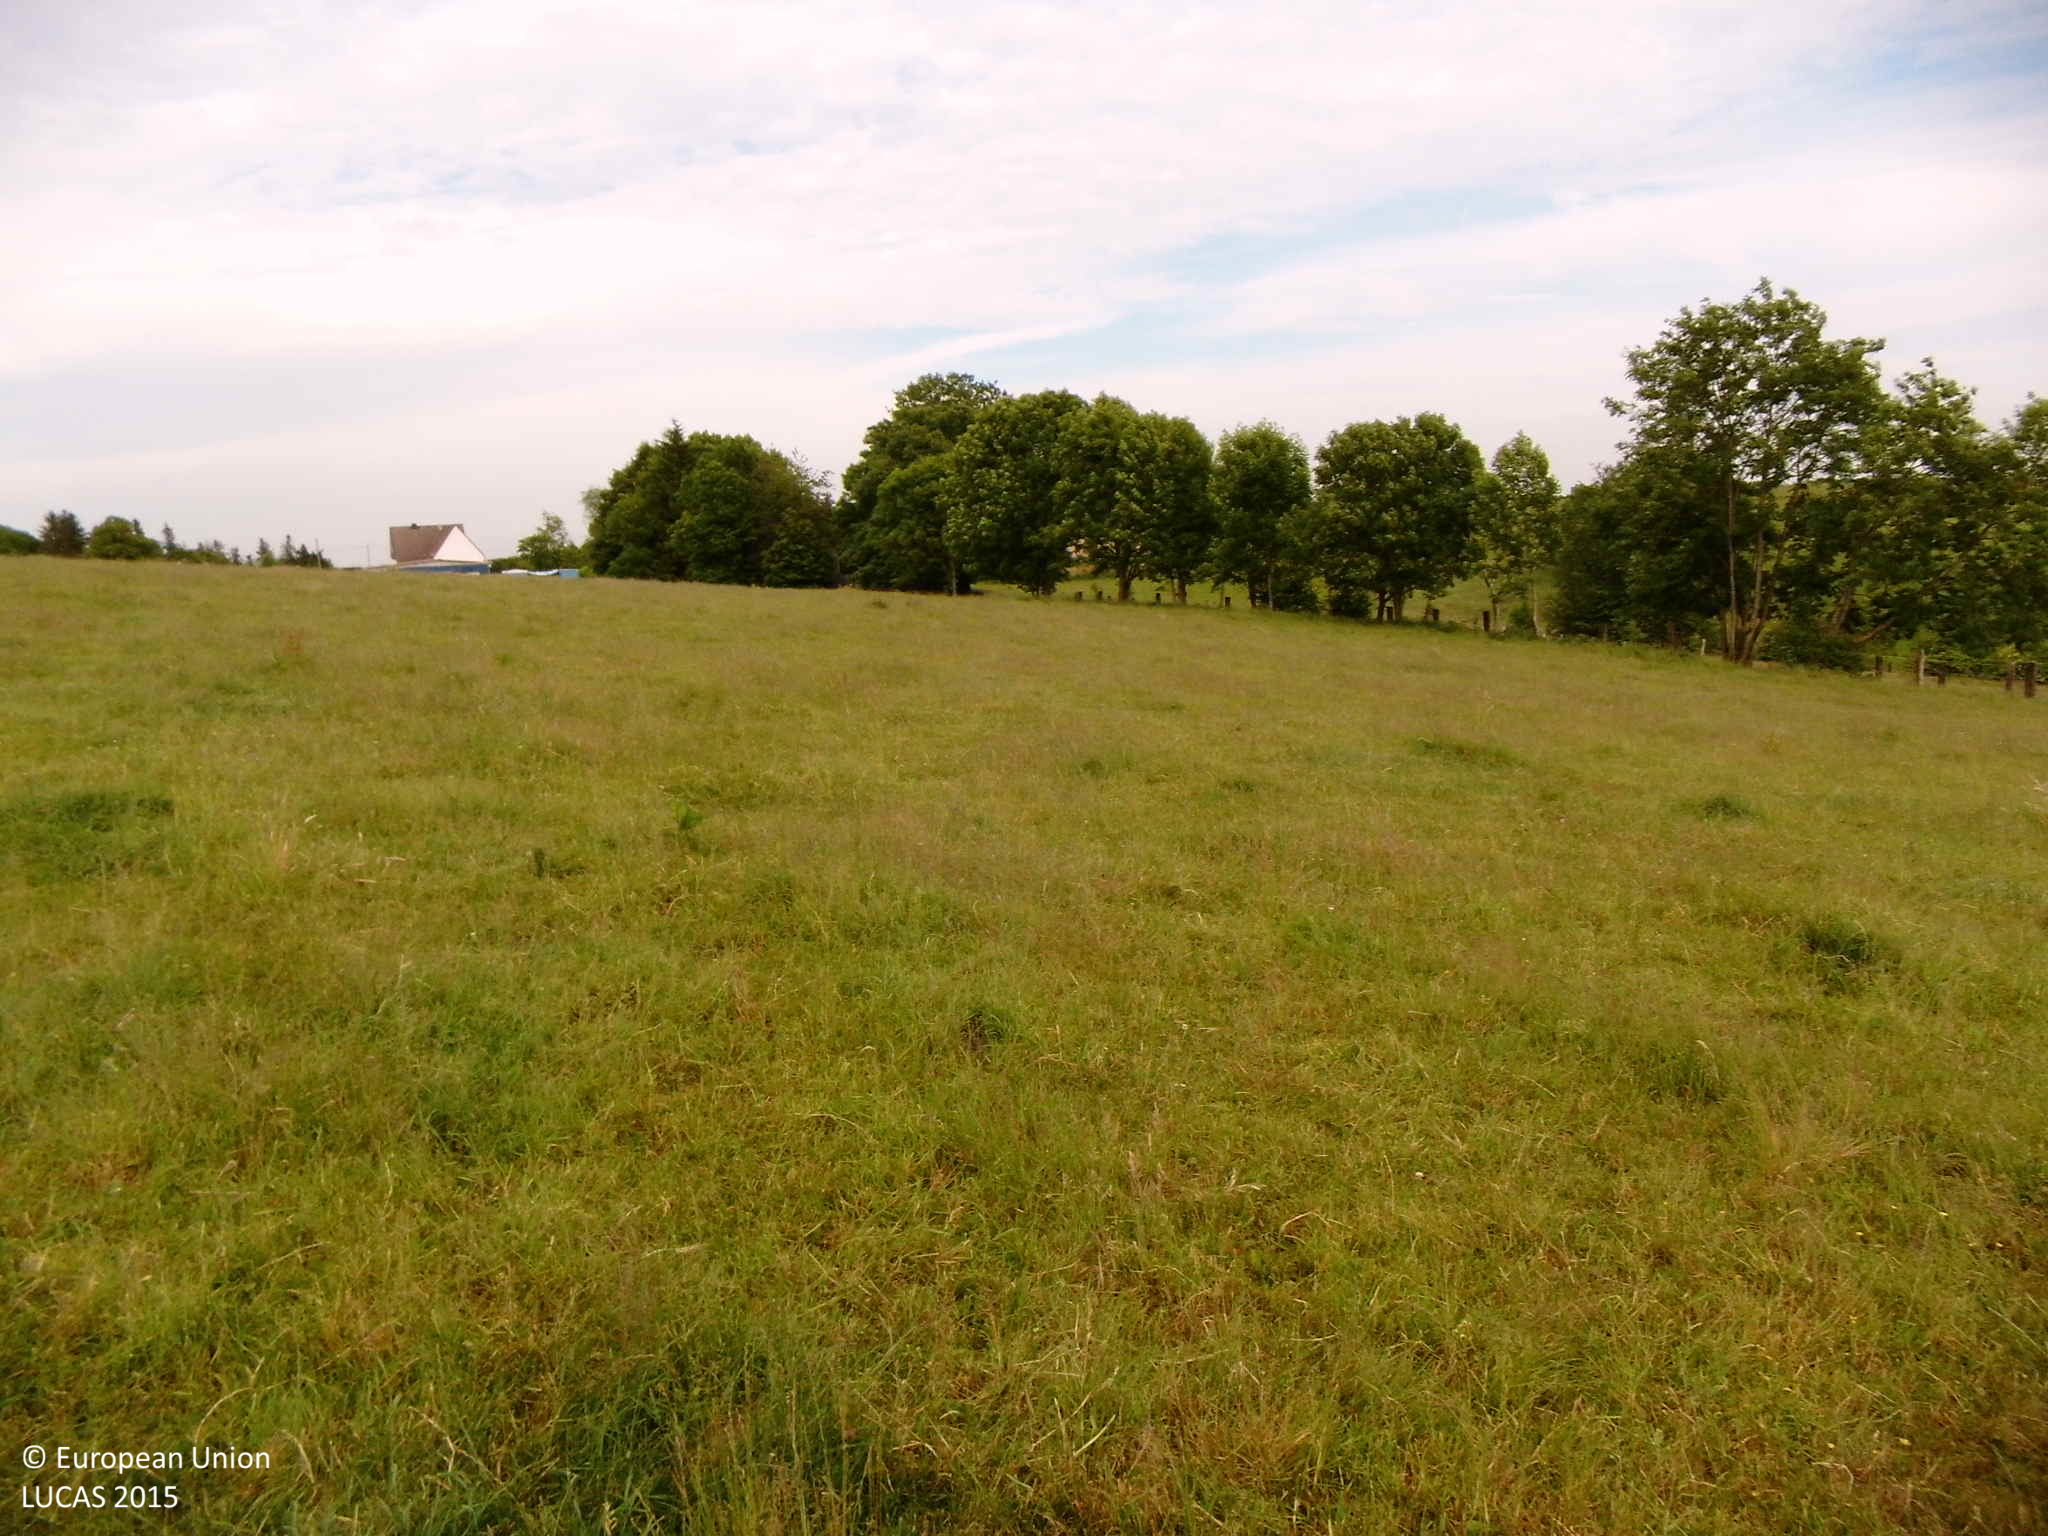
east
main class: Grassland
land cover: Grassland without tree/shrub cover
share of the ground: > 75 %
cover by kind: herbaceous plants 100 %
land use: Agriculture (excluding fallow land and kitchen gardens)
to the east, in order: Grassland without tree/shrub cover; Fences; Broadleaved woodland; Tracks; Fences; Grassland without tree/shrub cover
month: June
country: DE
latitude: 51.1982
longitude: 7.4099
